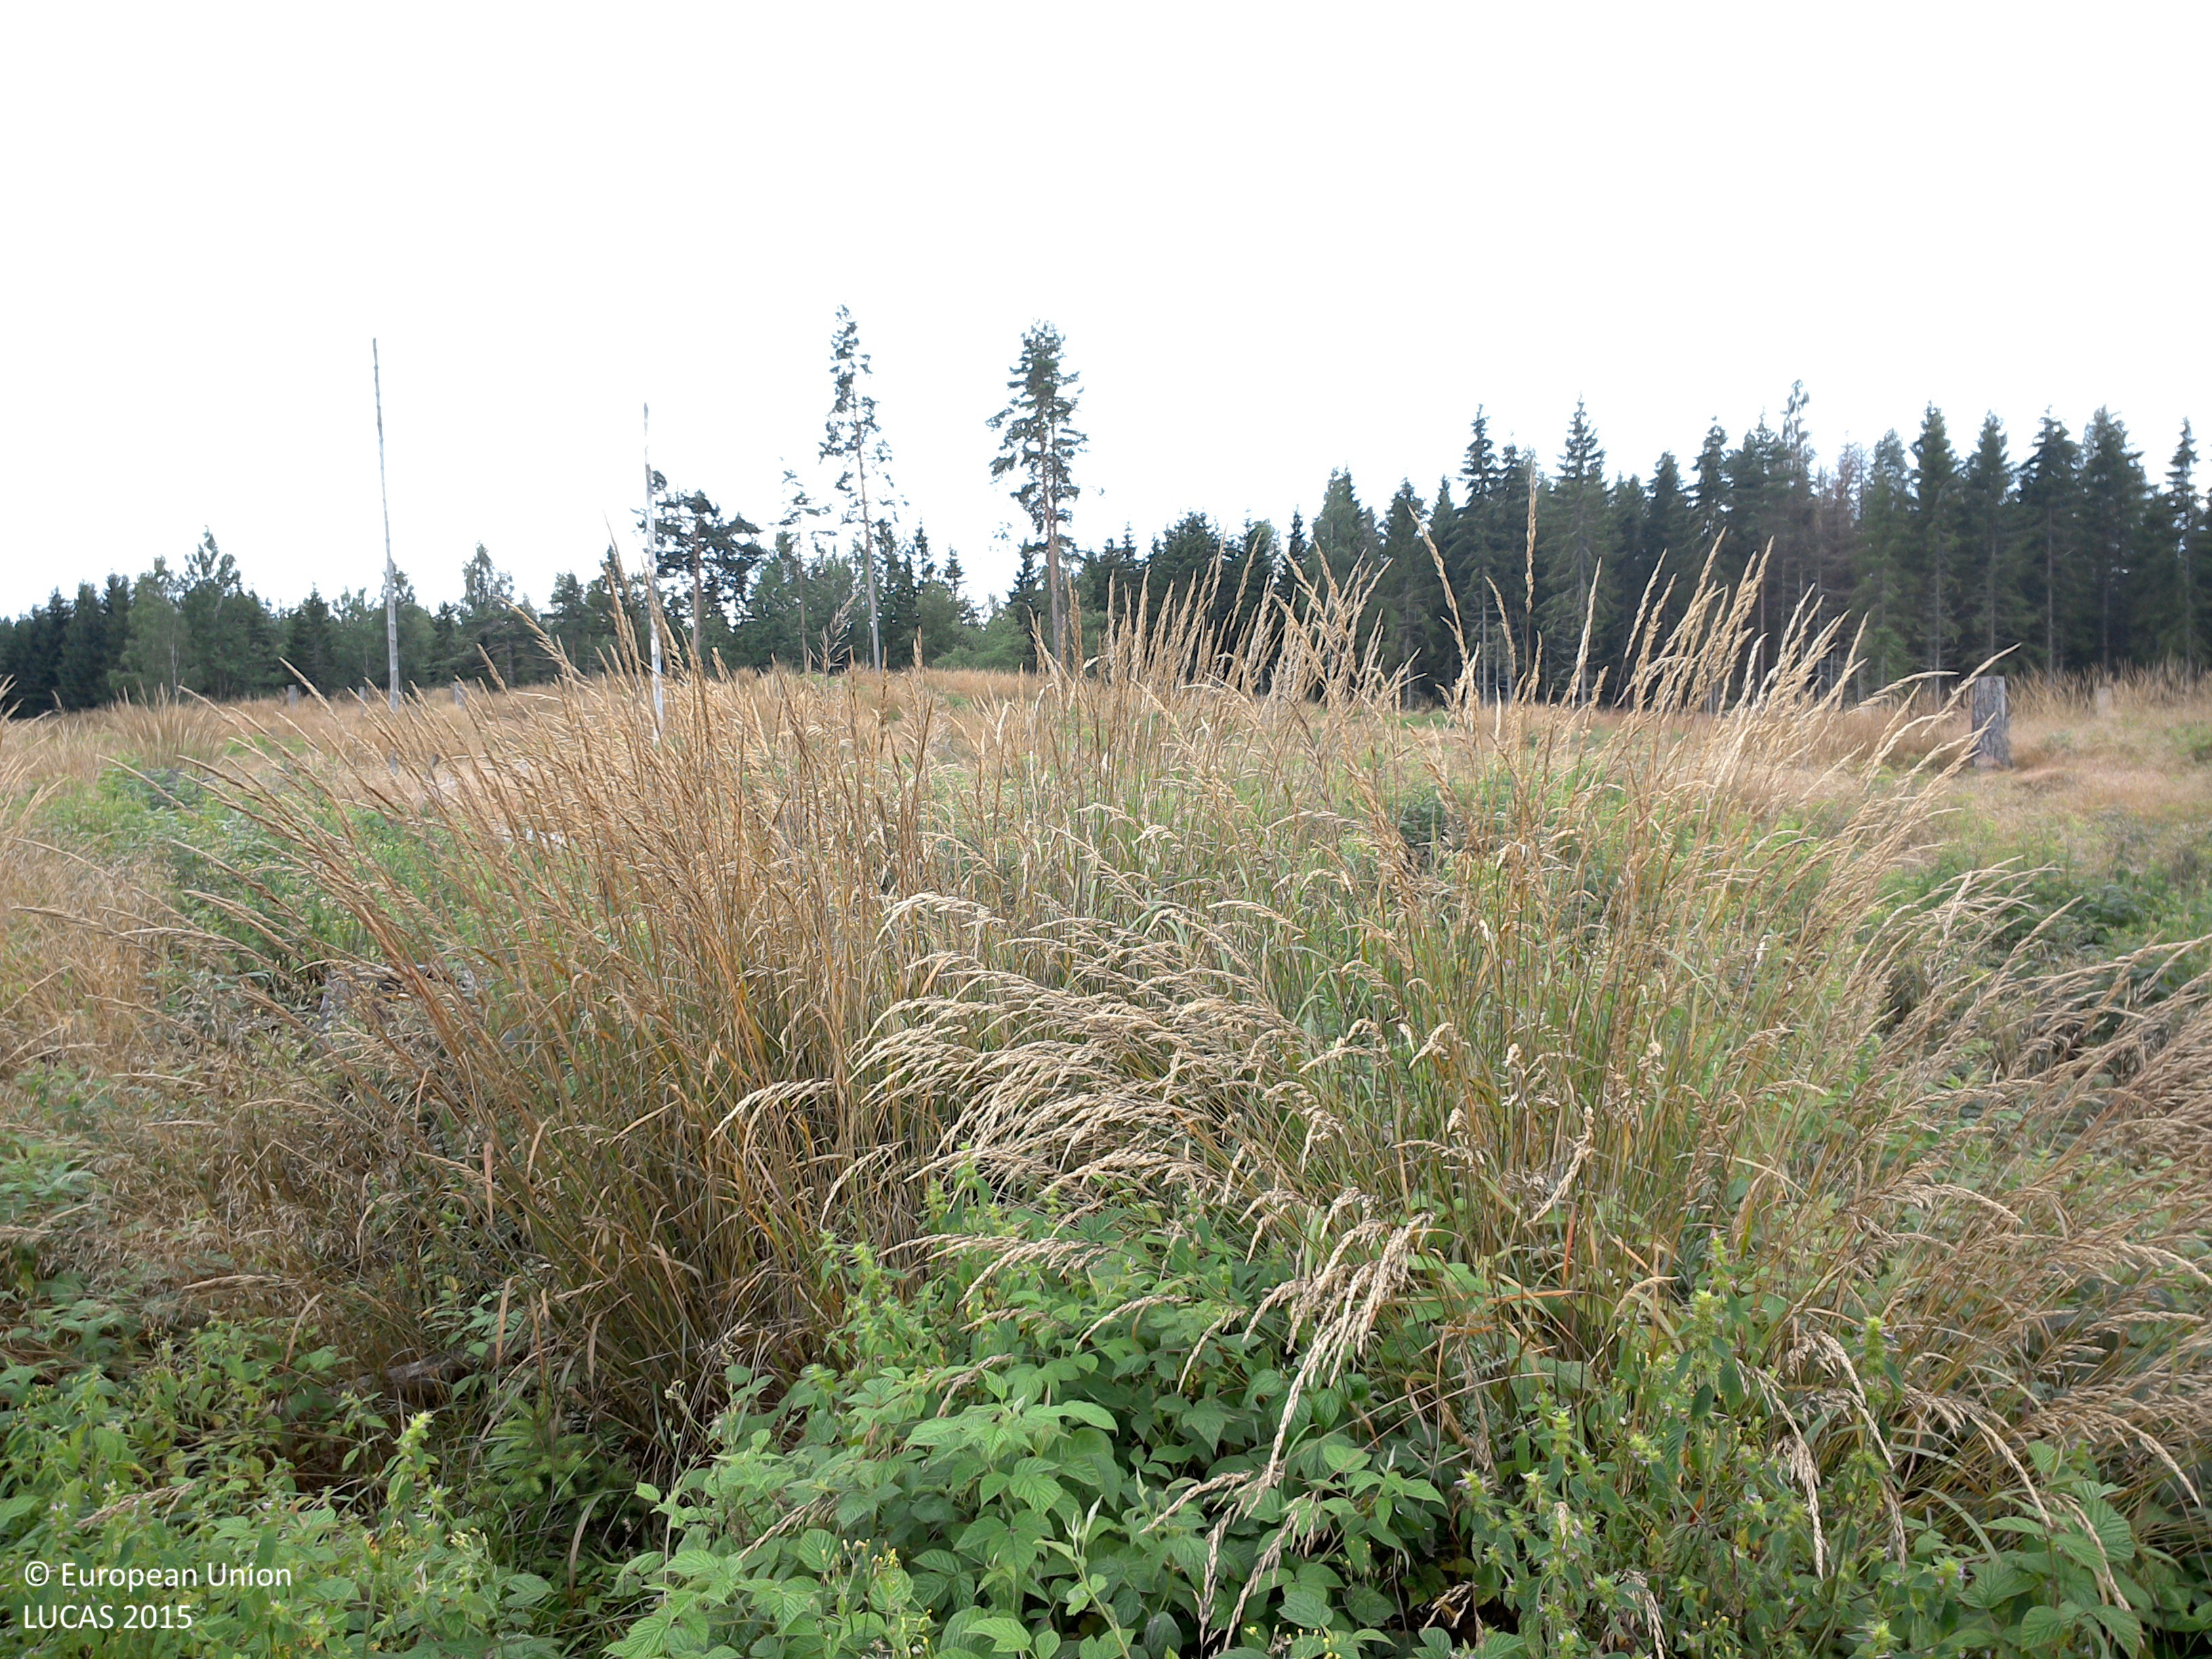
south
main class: Grassland
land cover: Grassland without tree/shrub cover
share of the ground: > 75 %
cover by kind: herbaceous plants 95 %, shrubs 5 %
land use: Forestry
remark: Clear cut
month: August
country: SE
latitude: 58.2030
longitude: 15.3547
